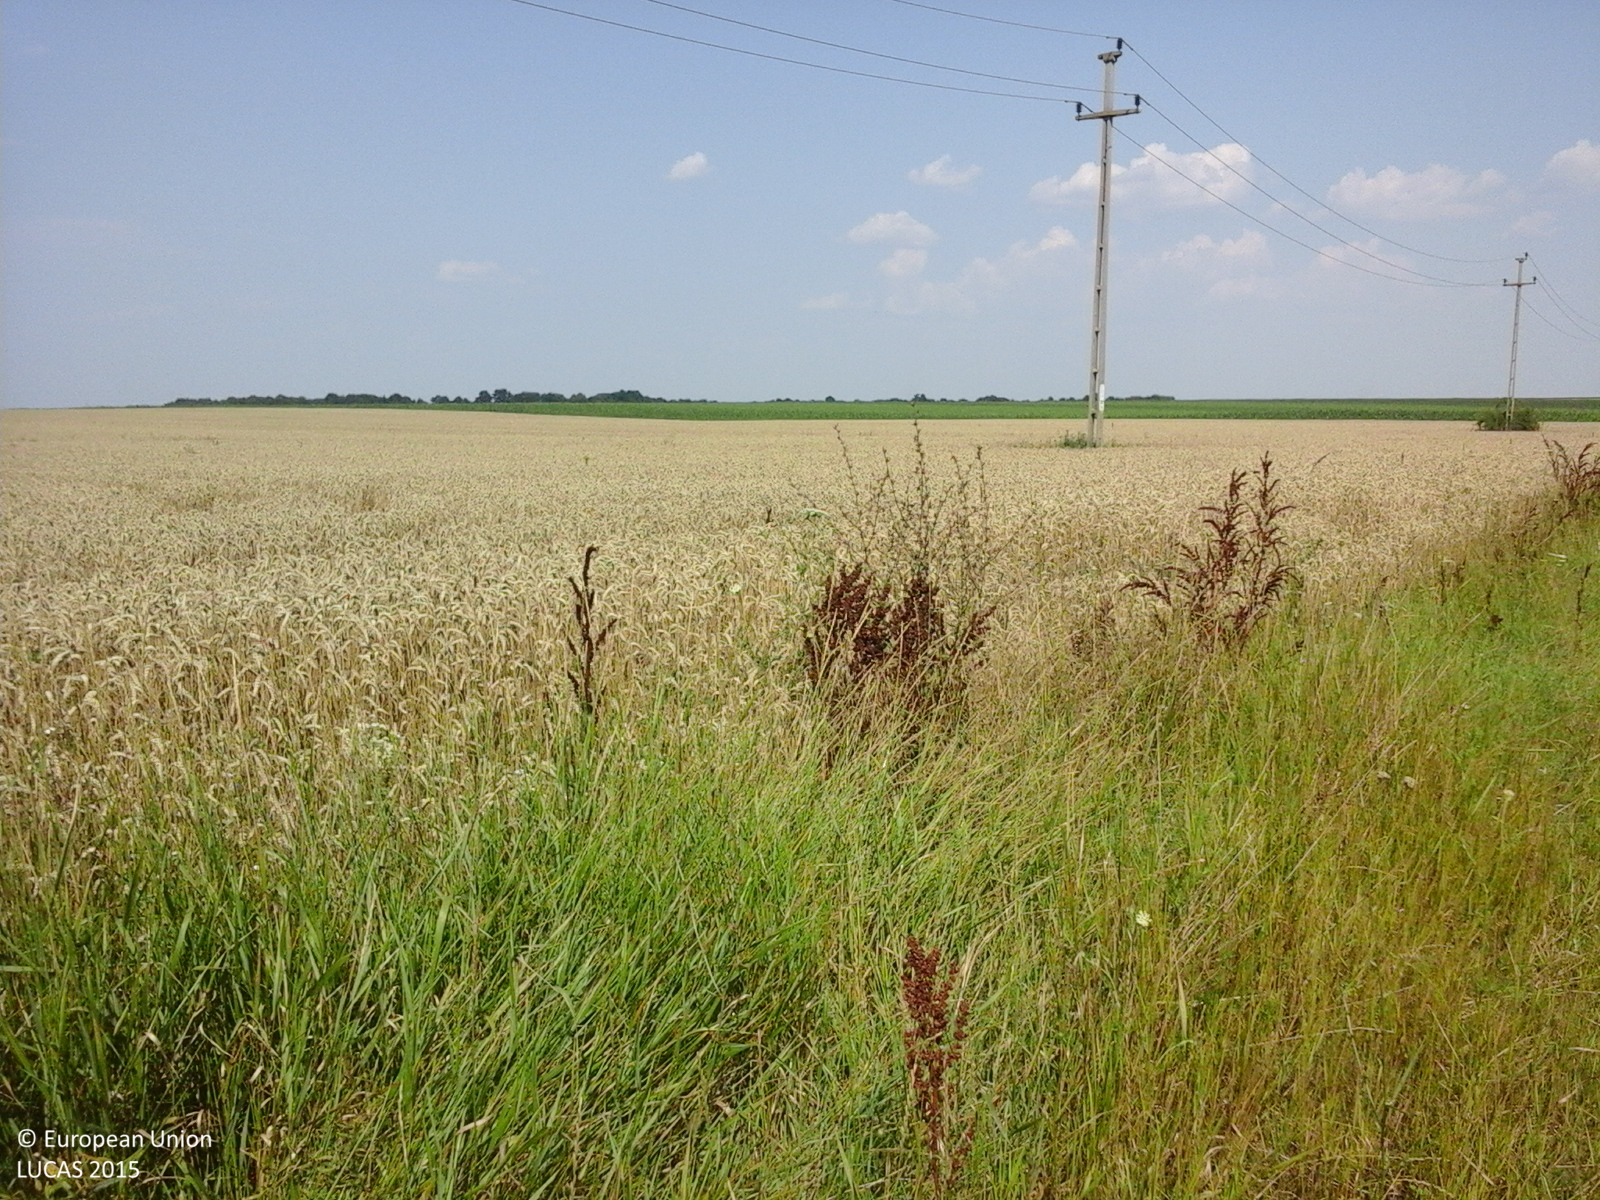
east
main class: Cropland
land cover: Common wheat
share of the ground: > 75 %
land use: Agriculture (excluding fallow land and kitchen gardens)
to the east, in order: Common wheat; Maize; Grass margins; Maize; Sunflower
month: July
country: RO
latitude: 44.5749
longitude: 24.9790
